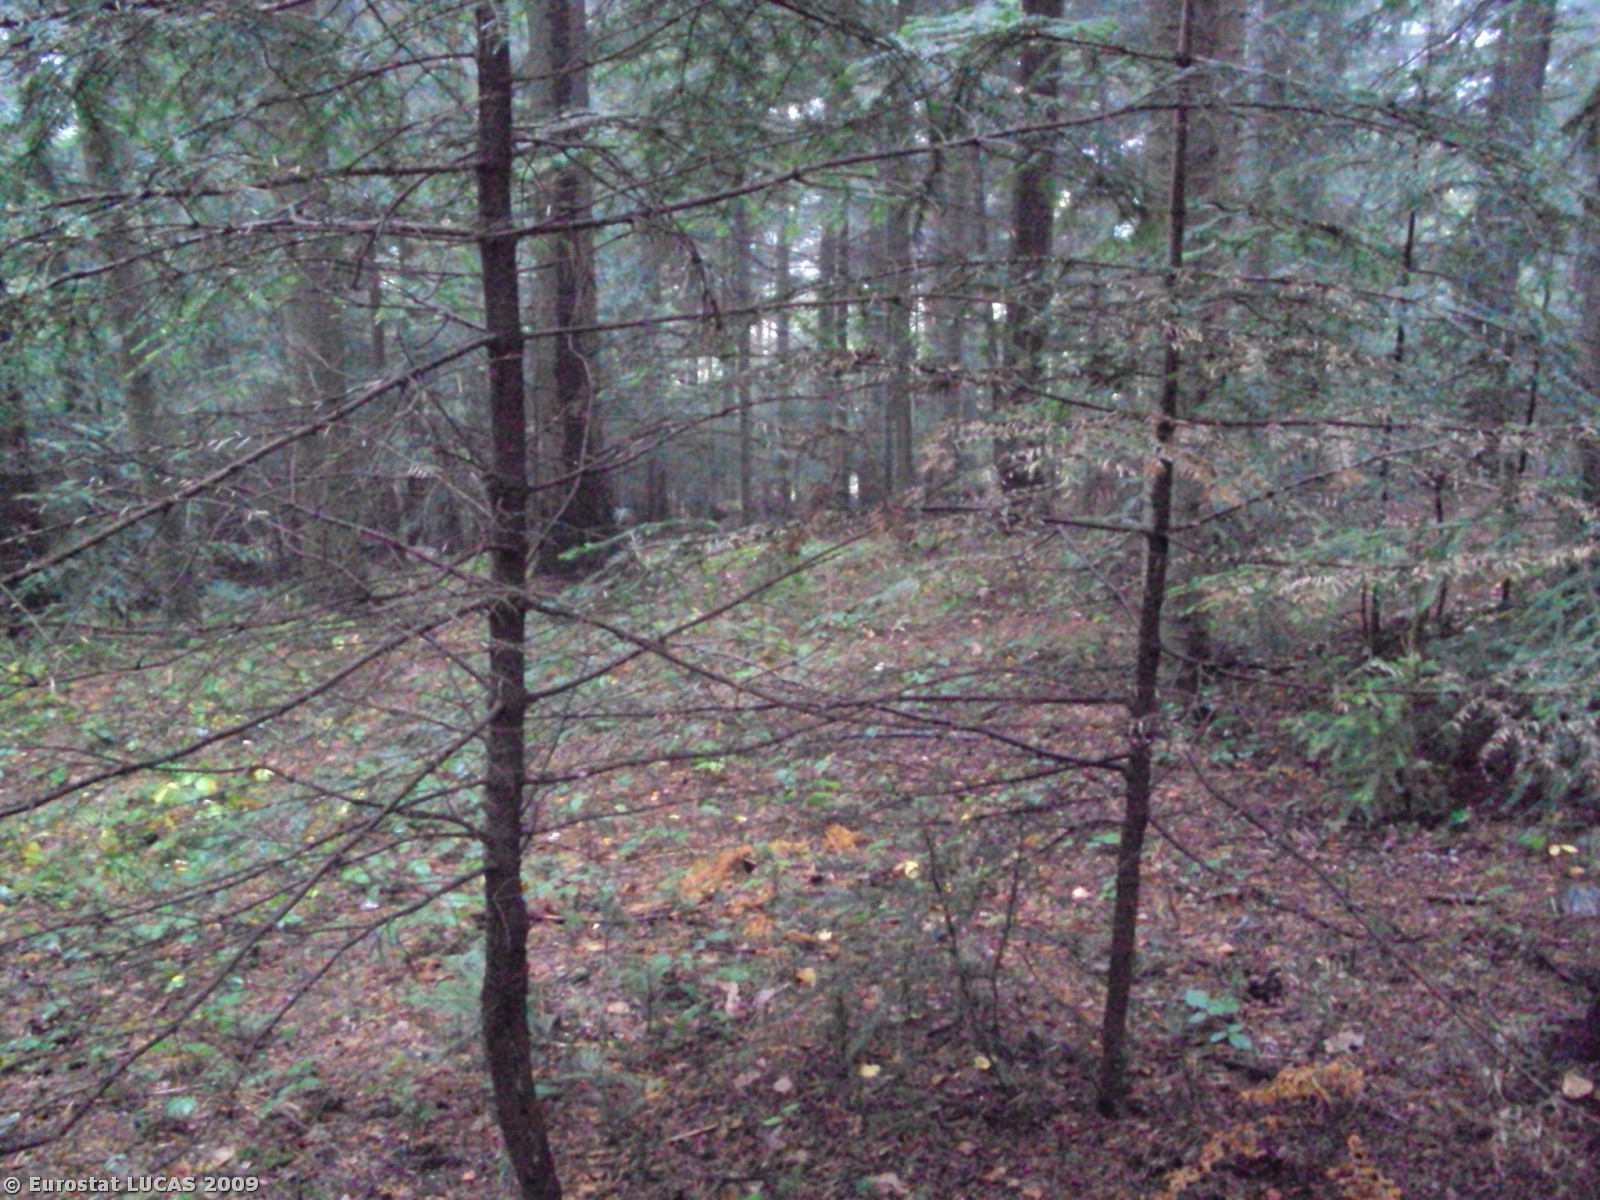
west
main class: Woodland
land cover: Coniferous woodland
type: hemiboreal forest and nemoral coniferous forest and mixed broadleaved-coniferous forest
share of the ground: > 75 %
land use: Unused
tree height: > 5 m
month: September
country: PL
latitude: 49.7304
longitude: 20.1471
